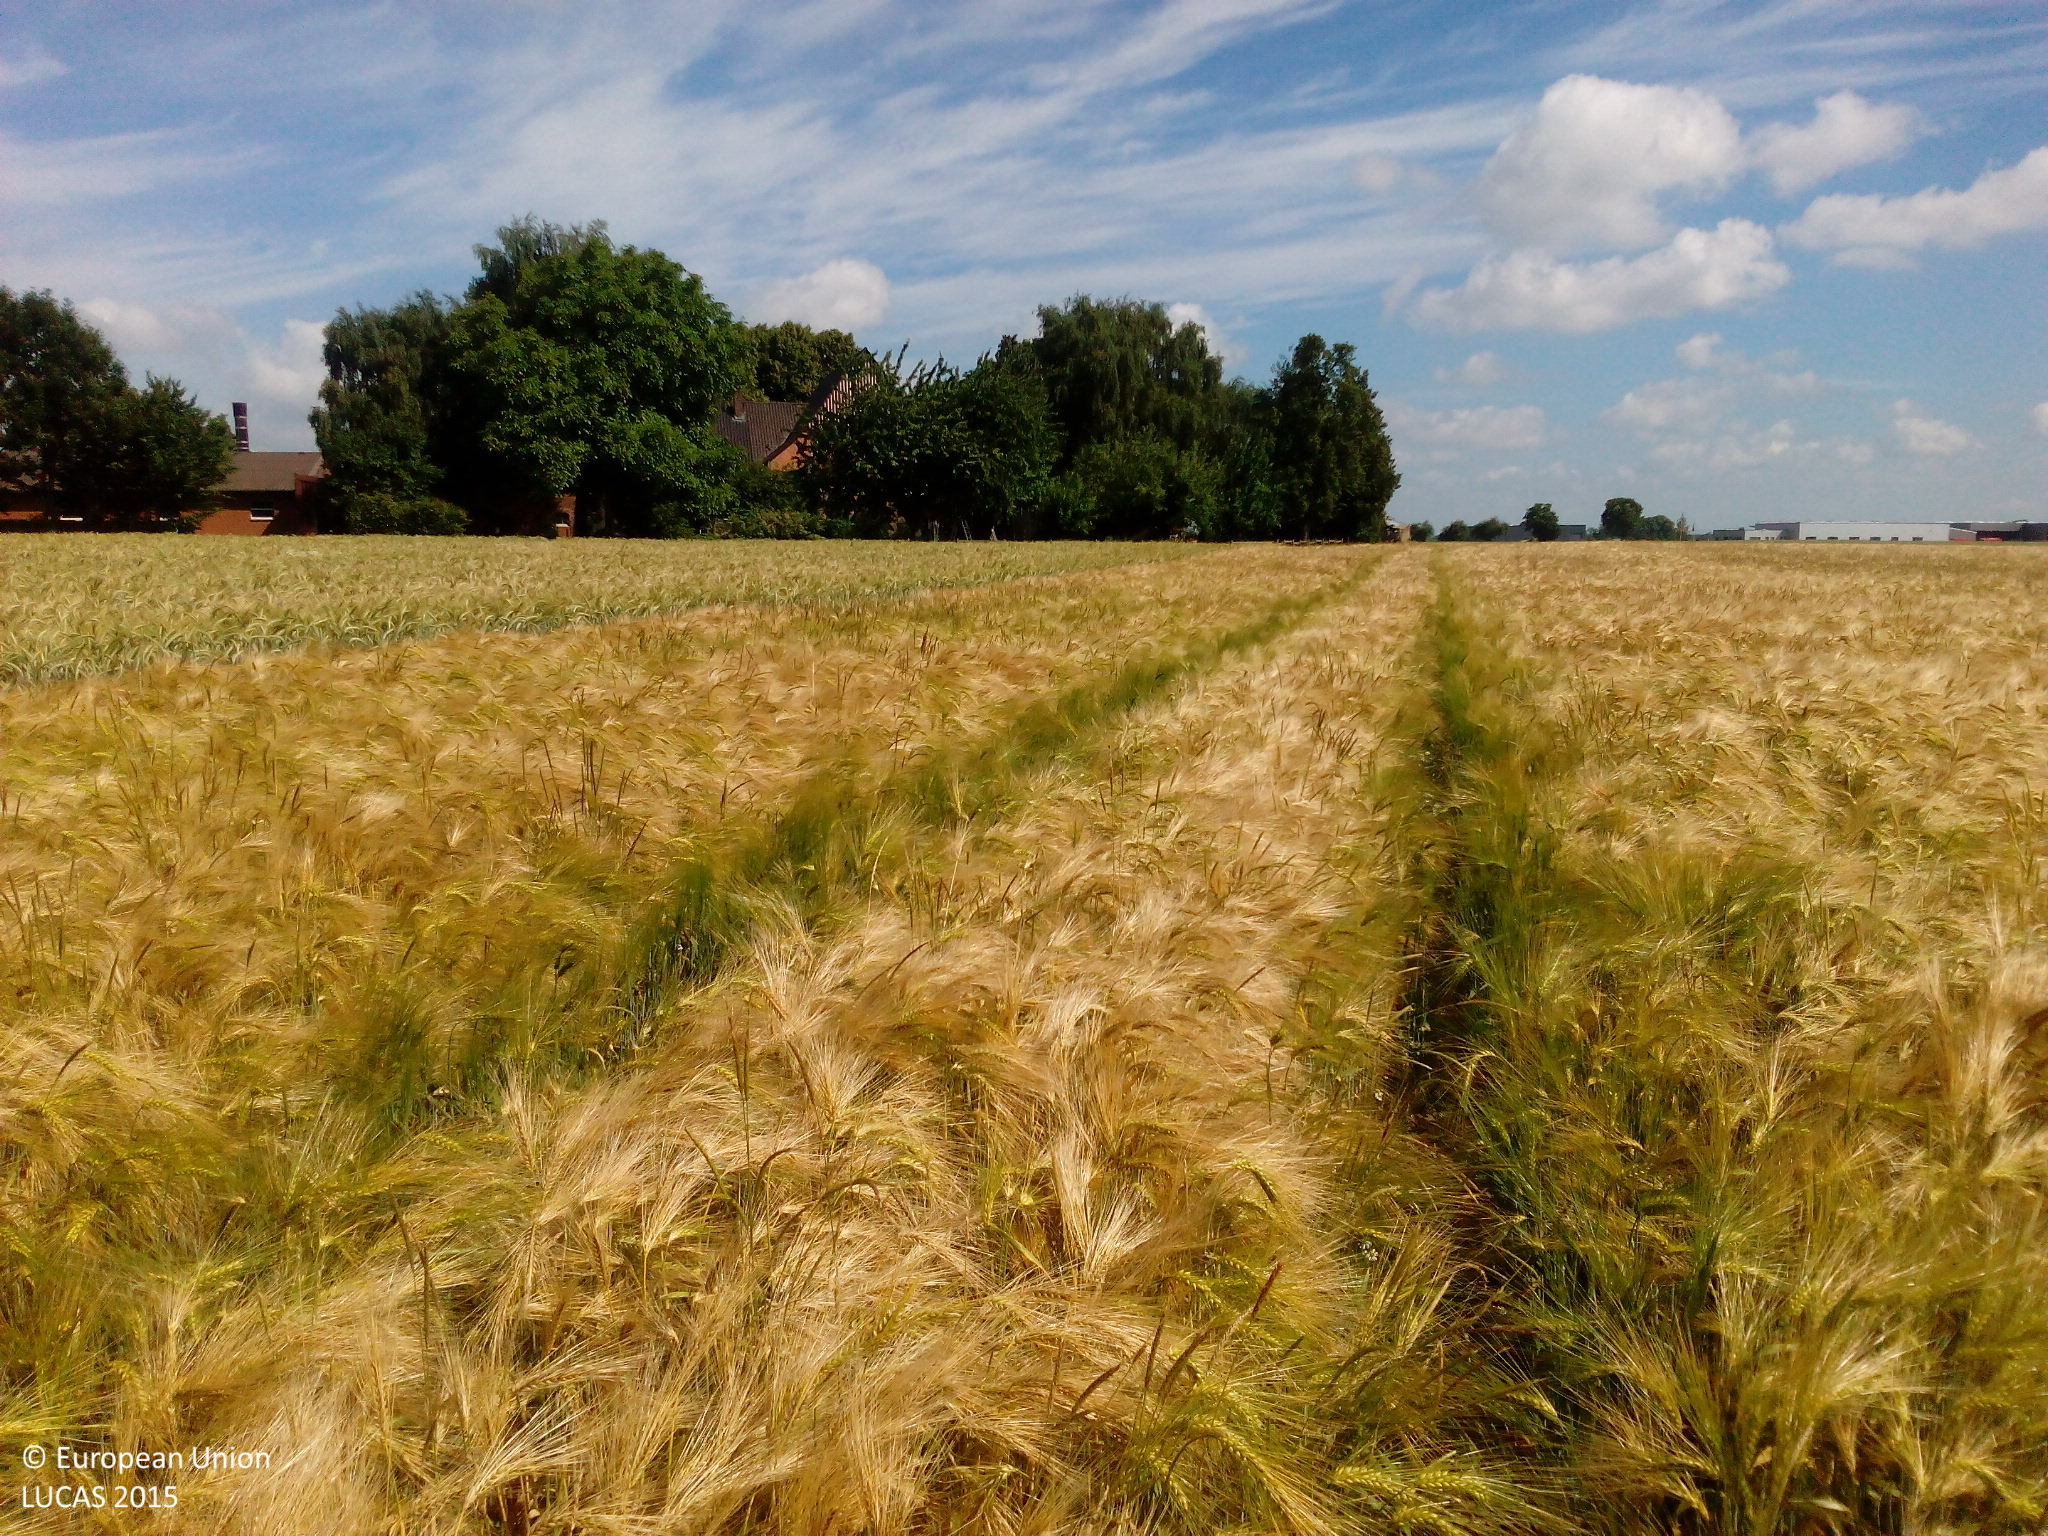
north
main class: Cropland
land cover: Barley
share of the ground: > 75 %
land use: Agriculture (excluding fallow land and kitchen gardens)
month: June
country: DE
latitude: 51.6677
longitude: 8.5690
